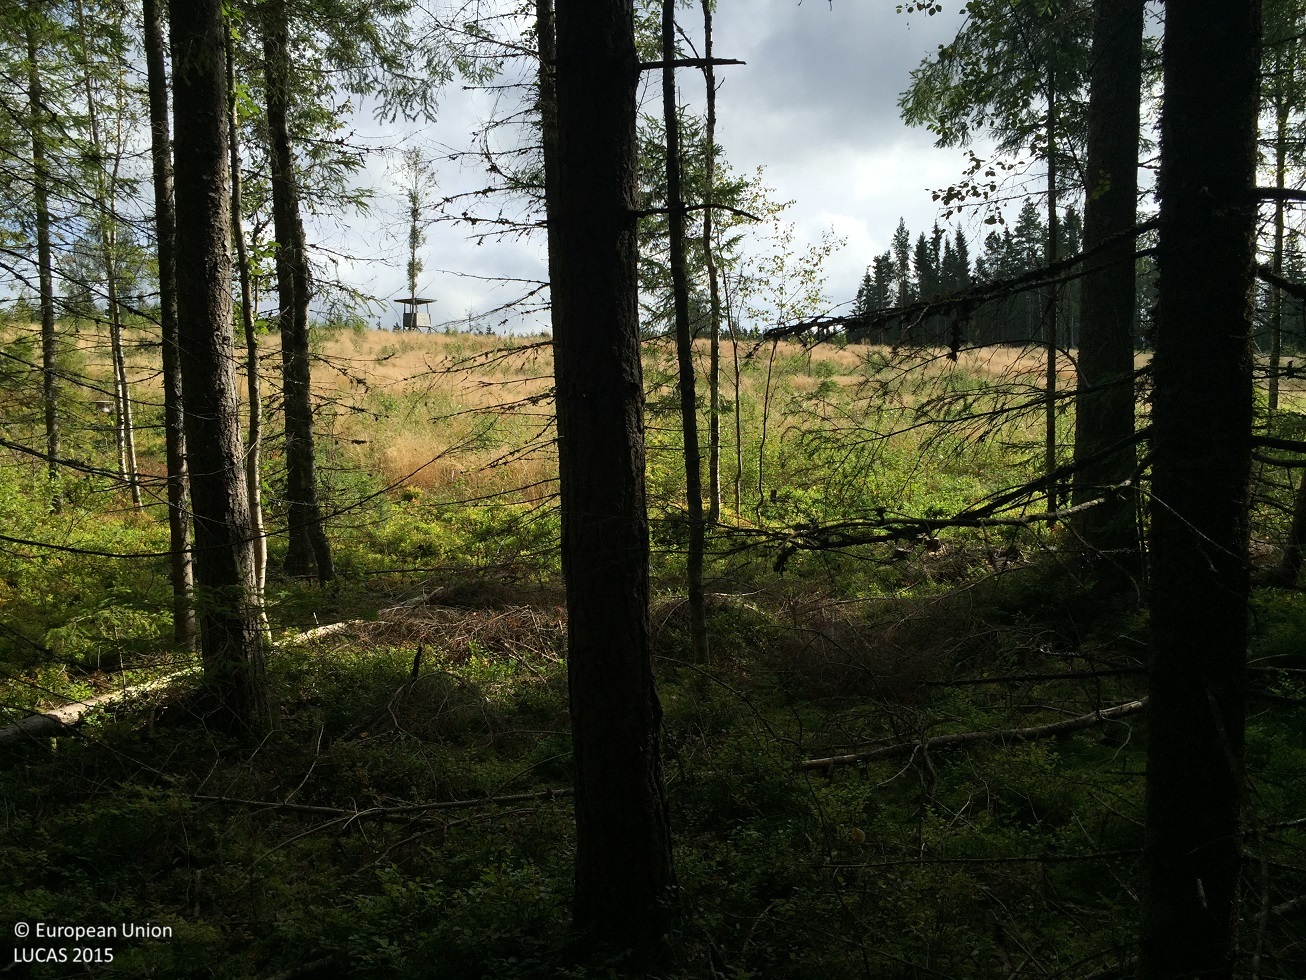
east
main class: Woodland
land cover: Spruce dominated mixed woodland
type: boreal forest
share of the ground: 50 - 75 %
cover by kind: coniferous forest trees 50 %, broadleaved forest trees 25 %, shrubs 15 %, lichens and mosses 10 %
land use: Forestry
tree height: > 5 m
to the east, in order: Spruce dominated mixed woodland; Tracks; Spruce dominated mixed woodland; Ditches and canals; Tracks; Ditches and canals; Spruce dominated mixed woodland
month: August
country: SE
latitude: 59.6758
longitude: 13.2060
